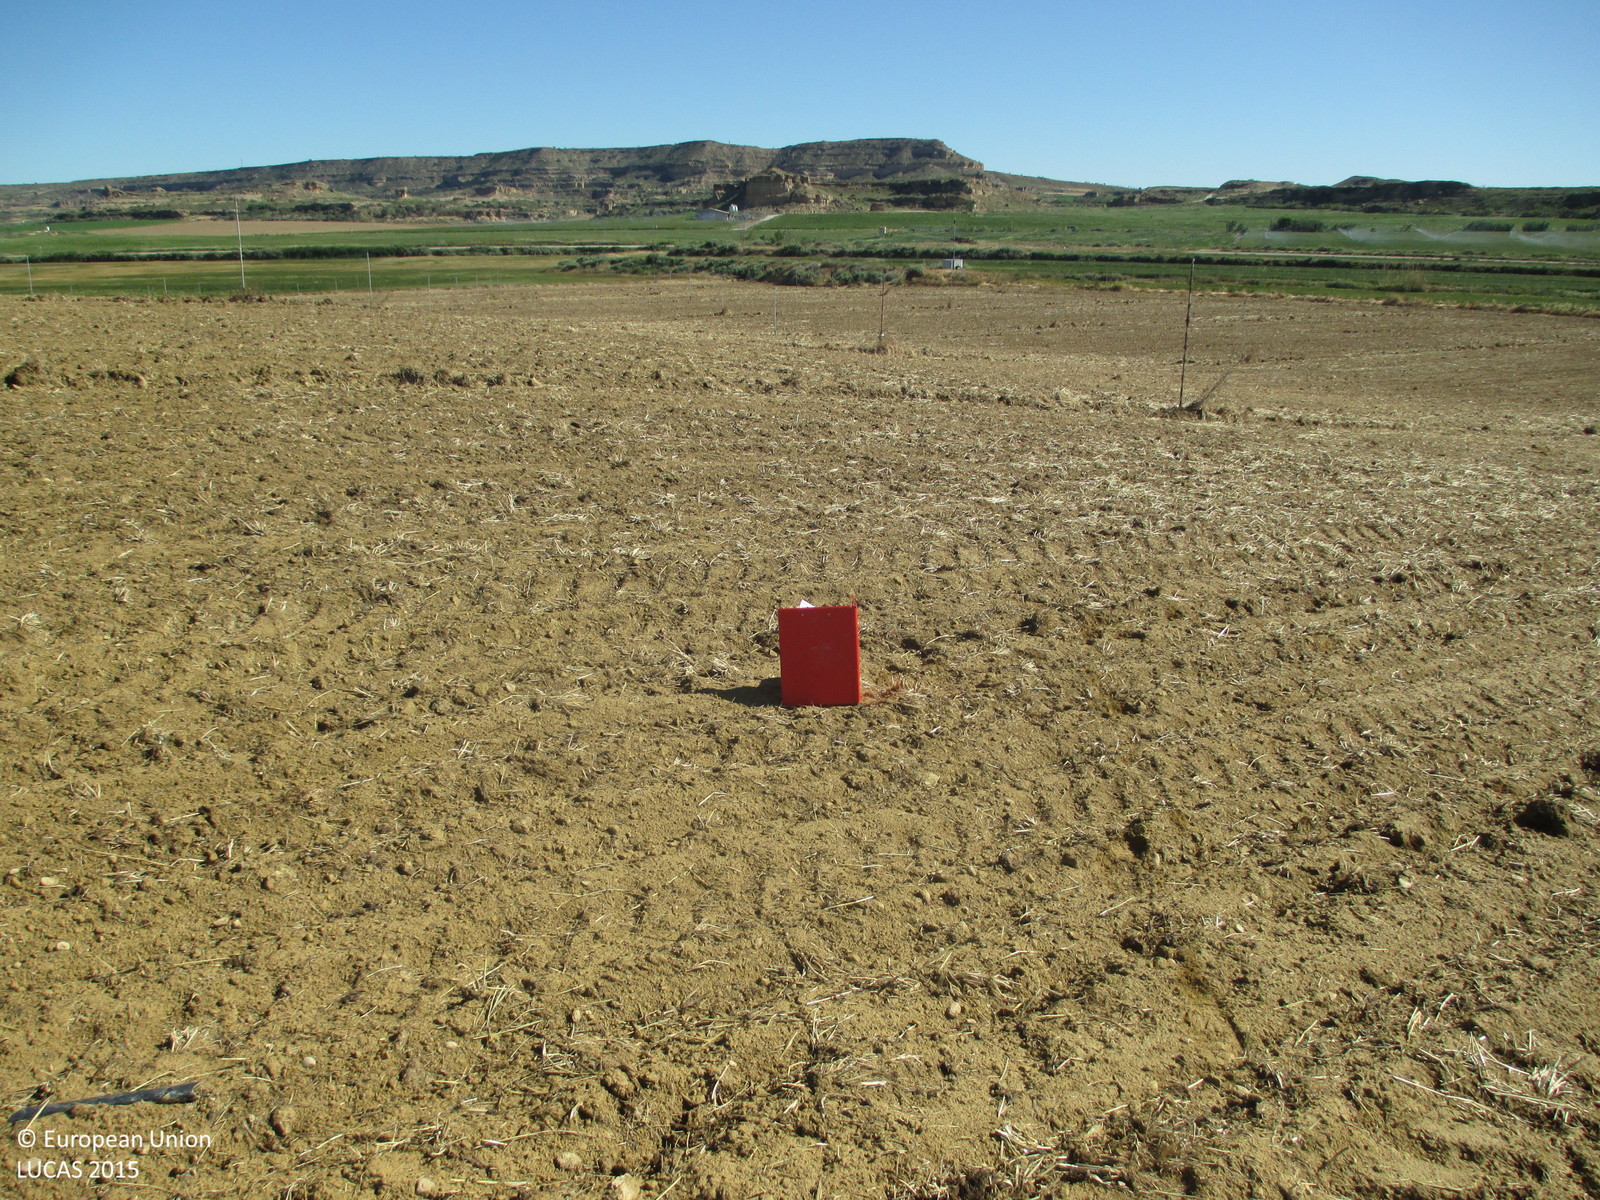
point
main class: Cropland
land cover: Maize
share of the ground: < 10 %
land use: Agriculture (excluding fallow land and kitchen gardens)
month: May
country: ES
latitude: 41.9008
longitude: -0.2049
